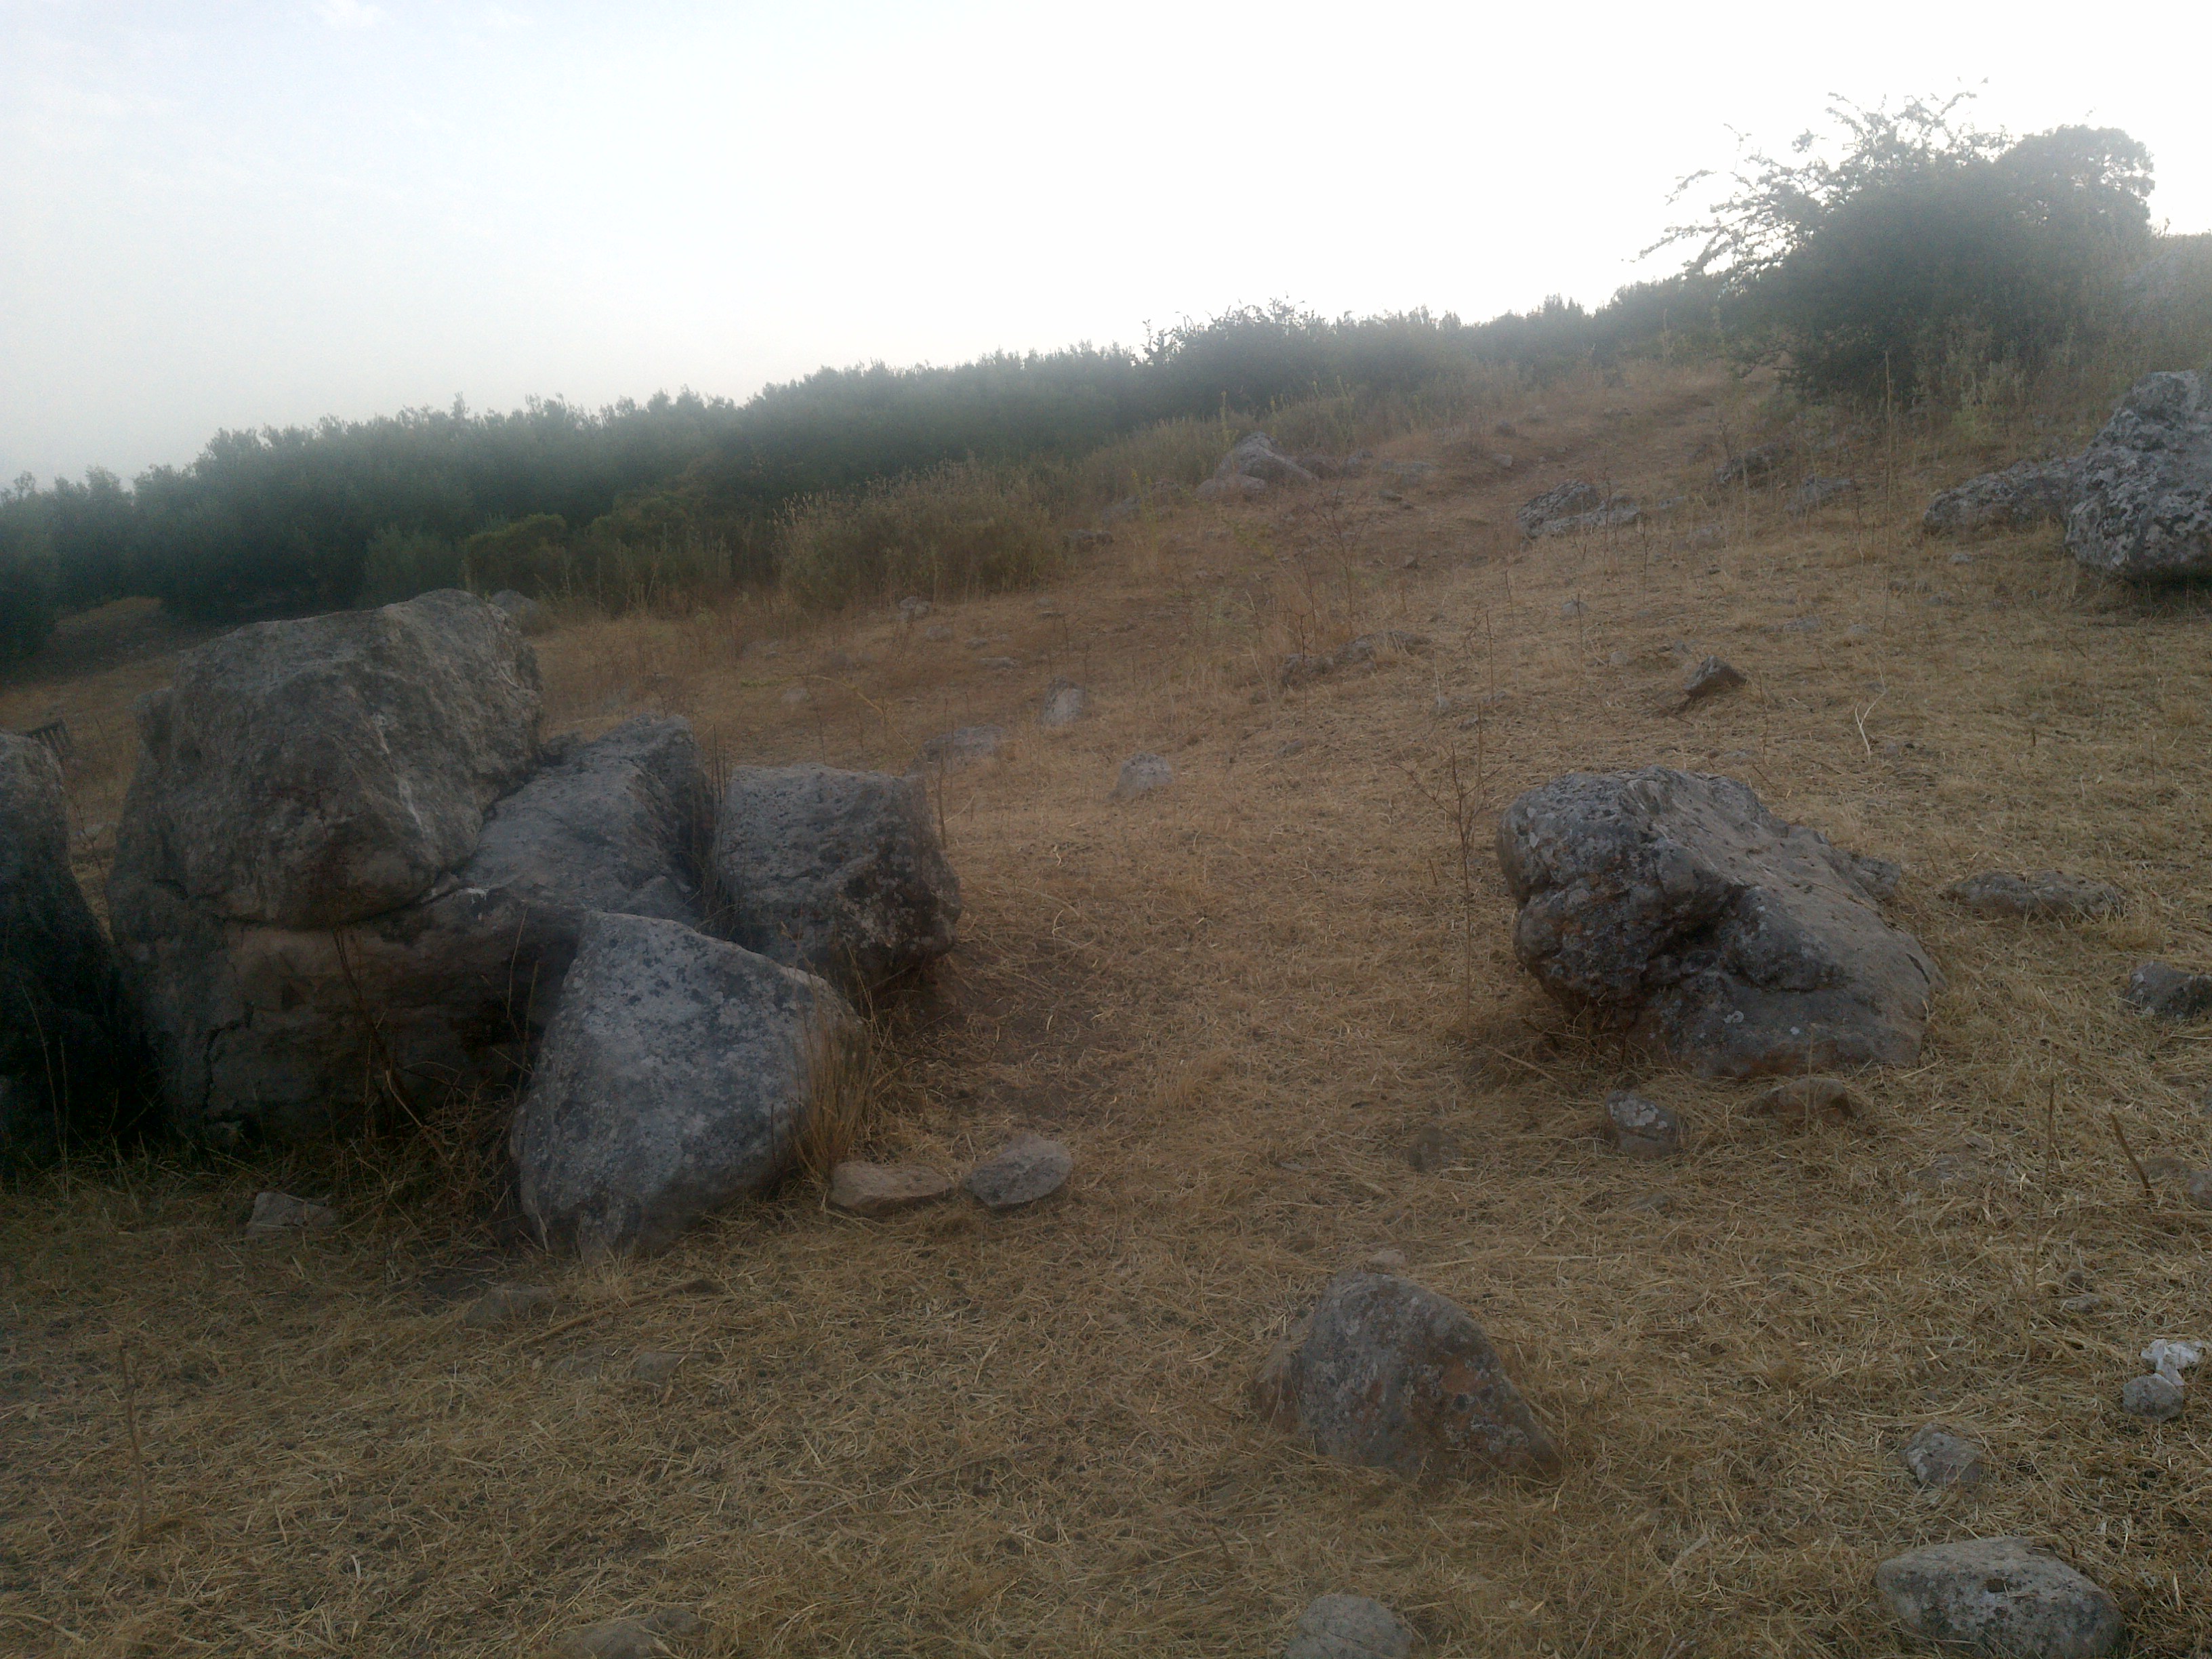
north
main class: Shrubland
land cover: Shrubland with sparse tree cover
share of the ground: 25 - 50 %
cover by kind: unconsolidated bare surface 60 %, shrubs 25 %, herbaceous plants 10 %, broadleaved forest trees 5 %
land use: Semi-natural and natural areas not in use
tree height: < 5 m
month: July
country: ES
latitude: 37.5299
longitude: -4.3861
